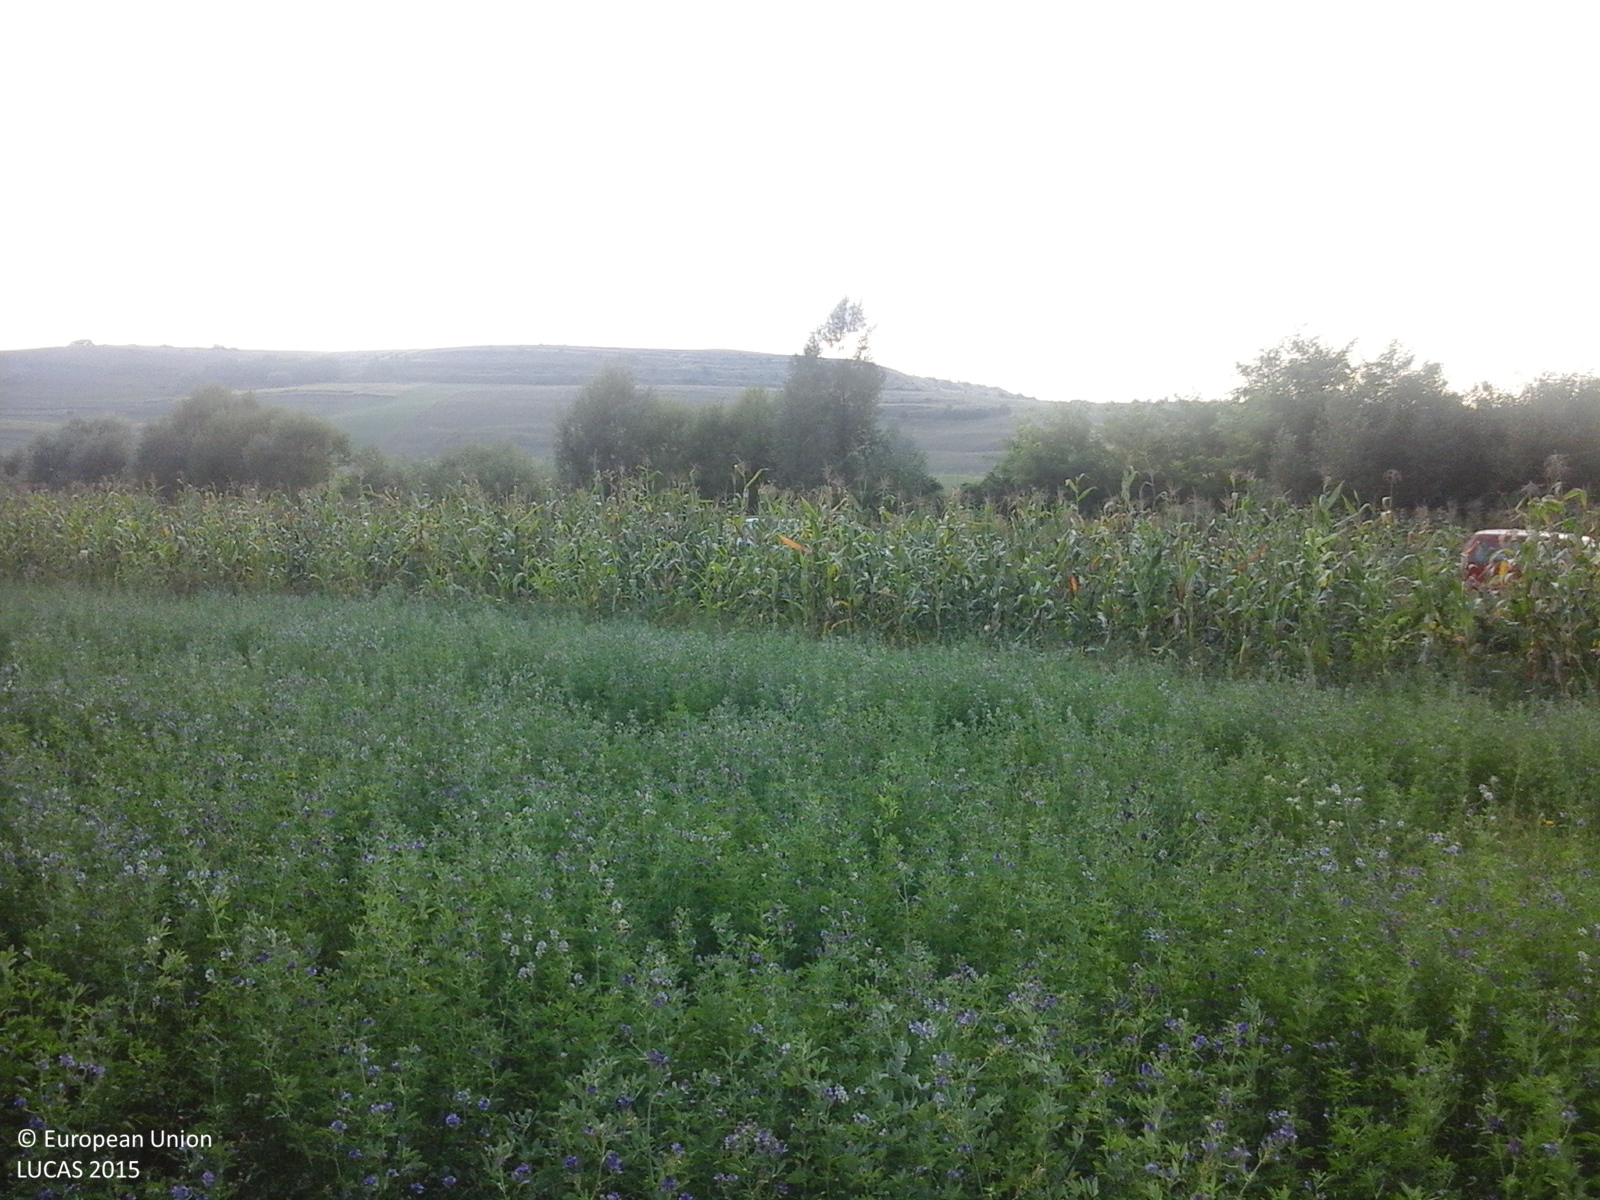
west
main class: Shrubland
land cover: Shrubland with sparse tree cover
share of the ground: > 75 %
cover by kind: shrubs 95 %, broadleaved forest trees 5 %
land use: Fallow land
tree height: > 5 m
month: September
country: RO
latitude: 47.0065
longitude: 24.1969
